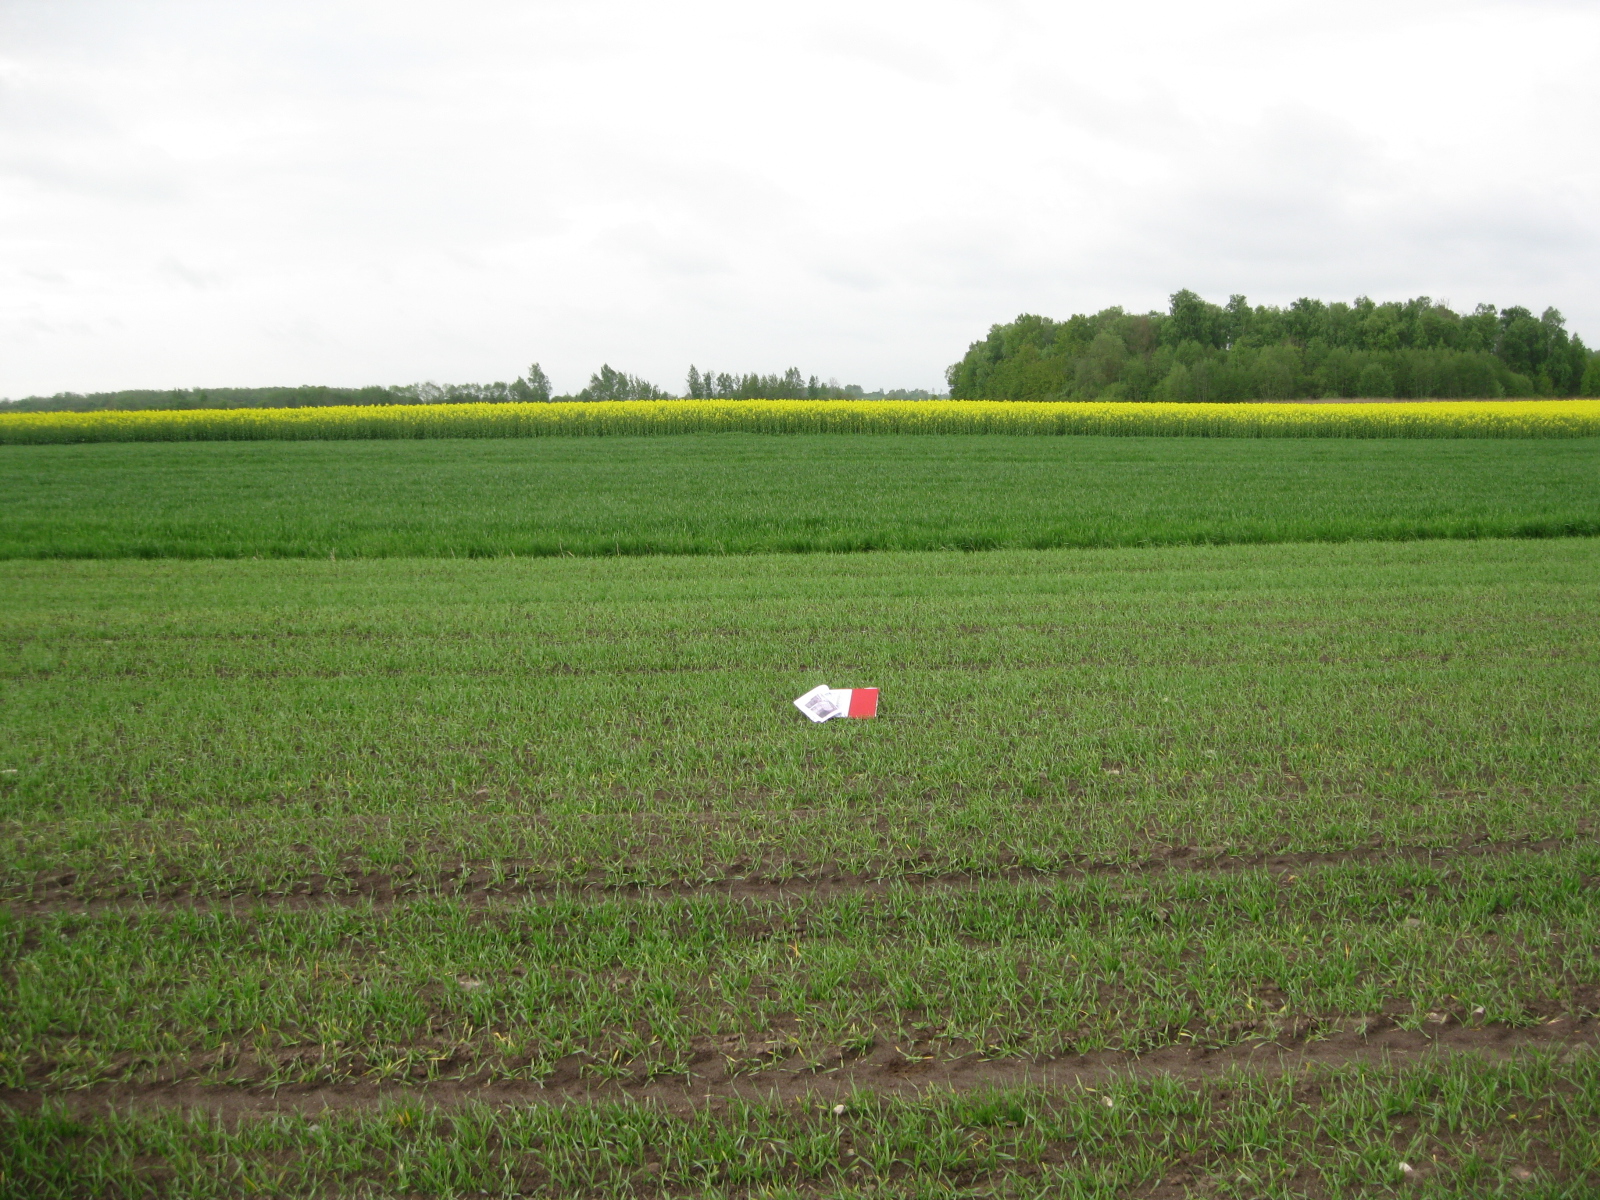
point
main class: Cropland
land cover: Barley
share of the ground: 10 - 25 %
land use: Agriculture (excluding fallow land and kitchen gardens)
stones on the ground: < 10 %
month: May
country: LT
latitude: 56.2577
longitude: 23.9845
